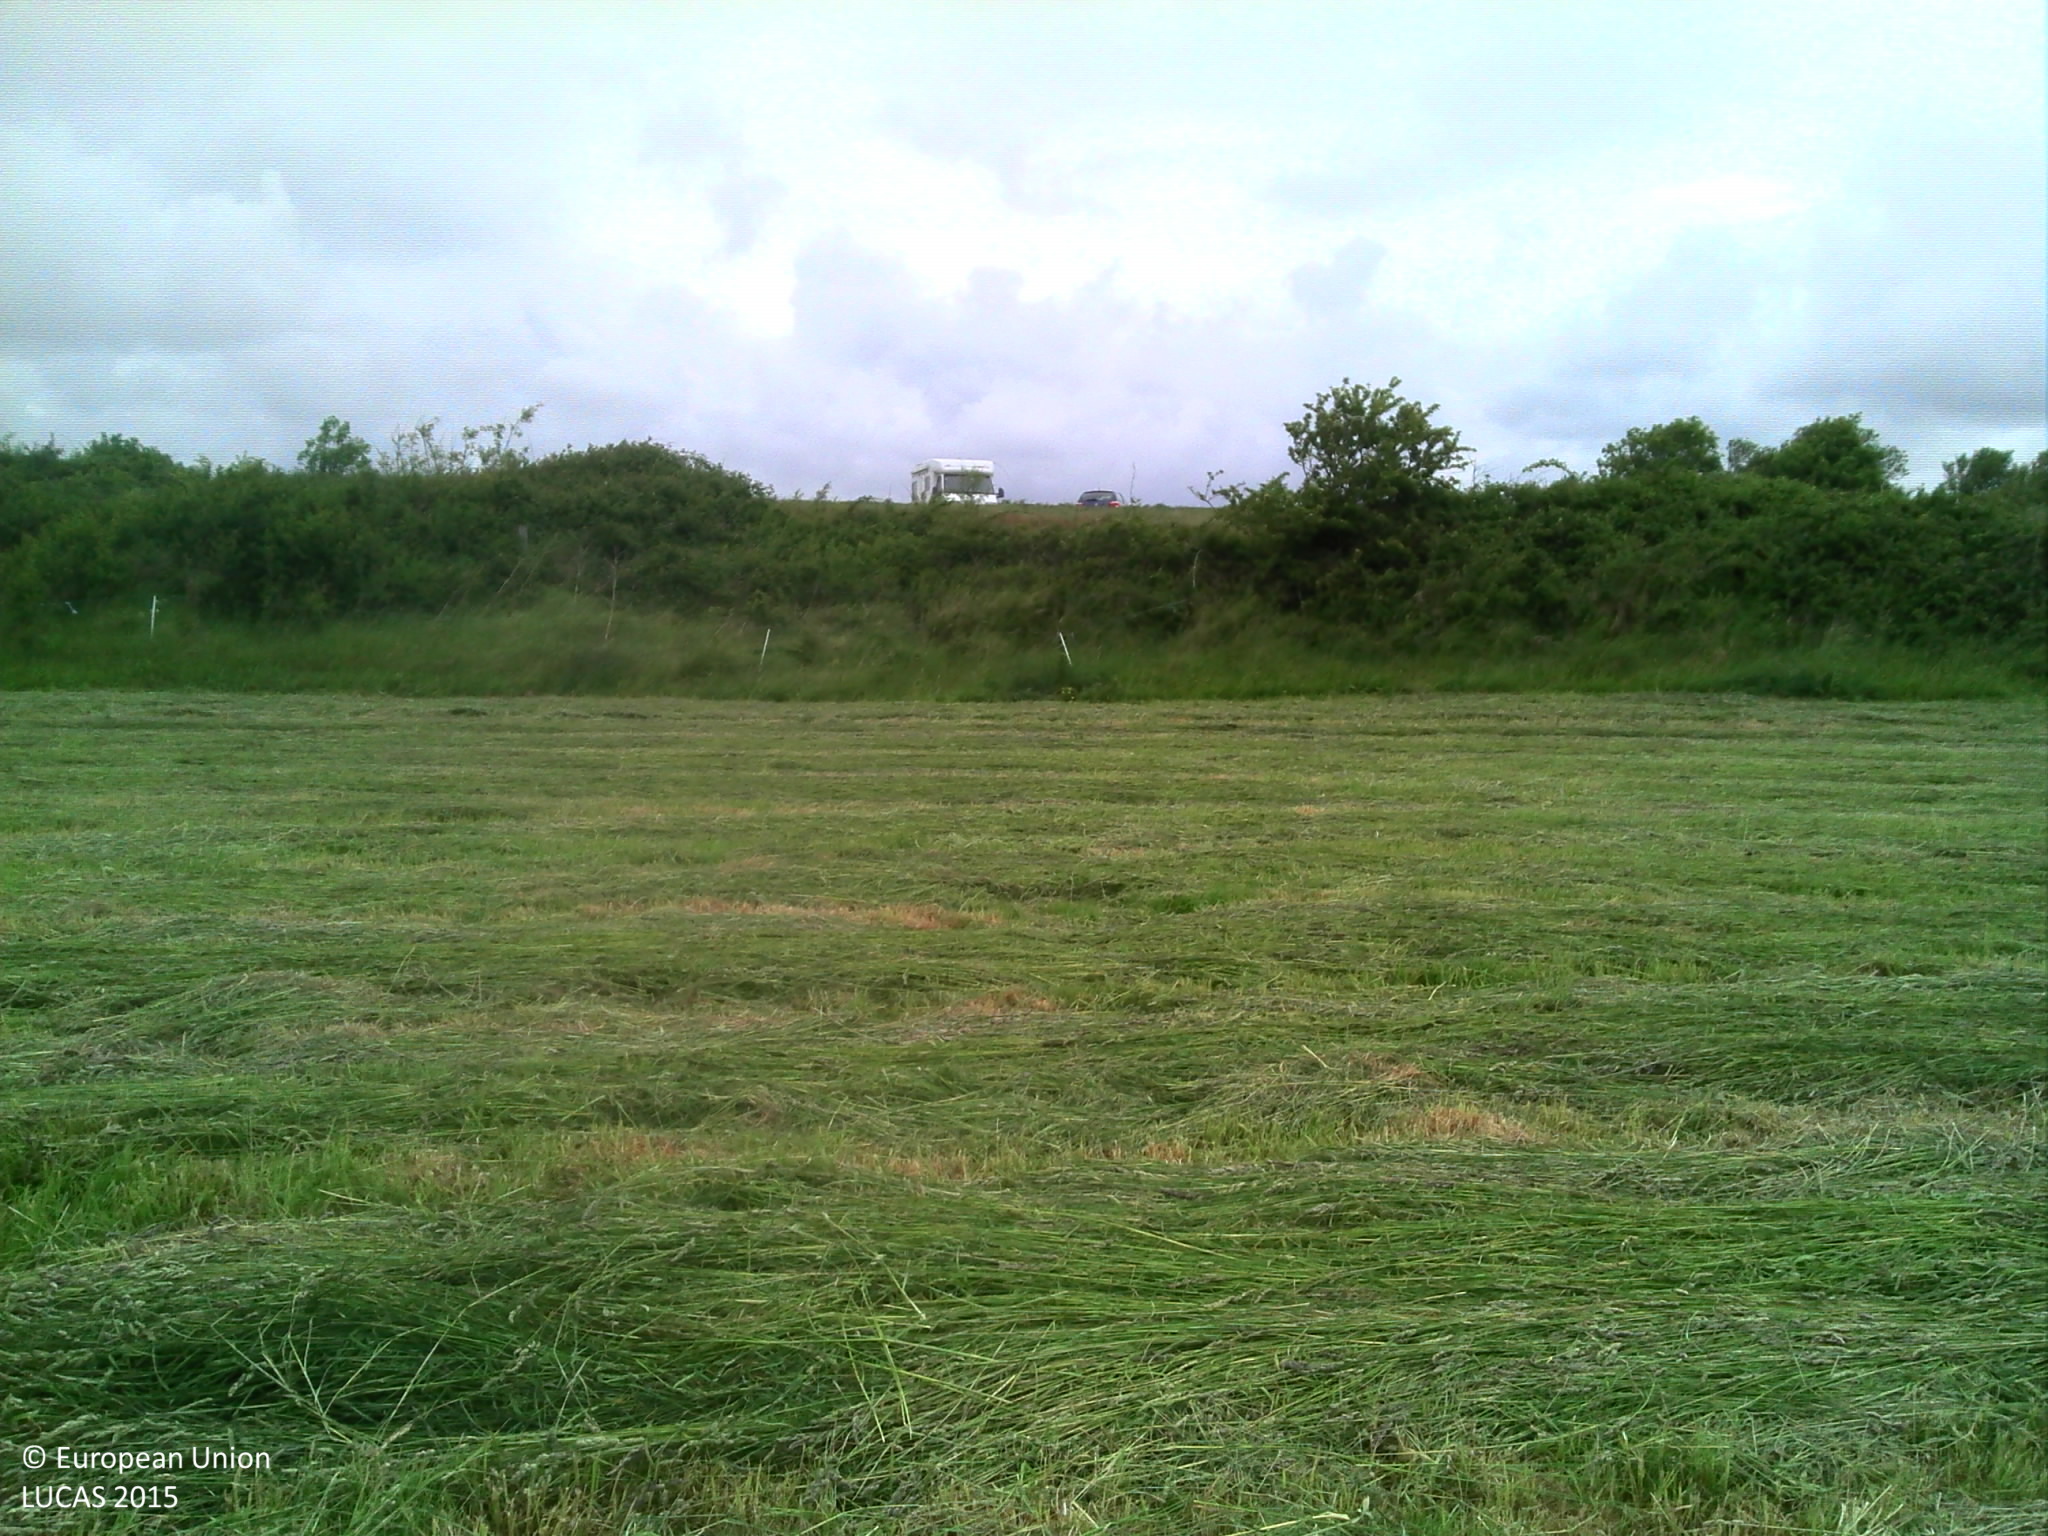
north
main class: Grassland
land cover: Grassland without tree/shrub cover
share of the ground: > 75 %
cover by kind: herbaceous plants 100 %
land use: Agriculture (excluding fallow land and kitchen gardens)
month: May
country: FR
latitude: 50.2144
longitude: 1.5591
